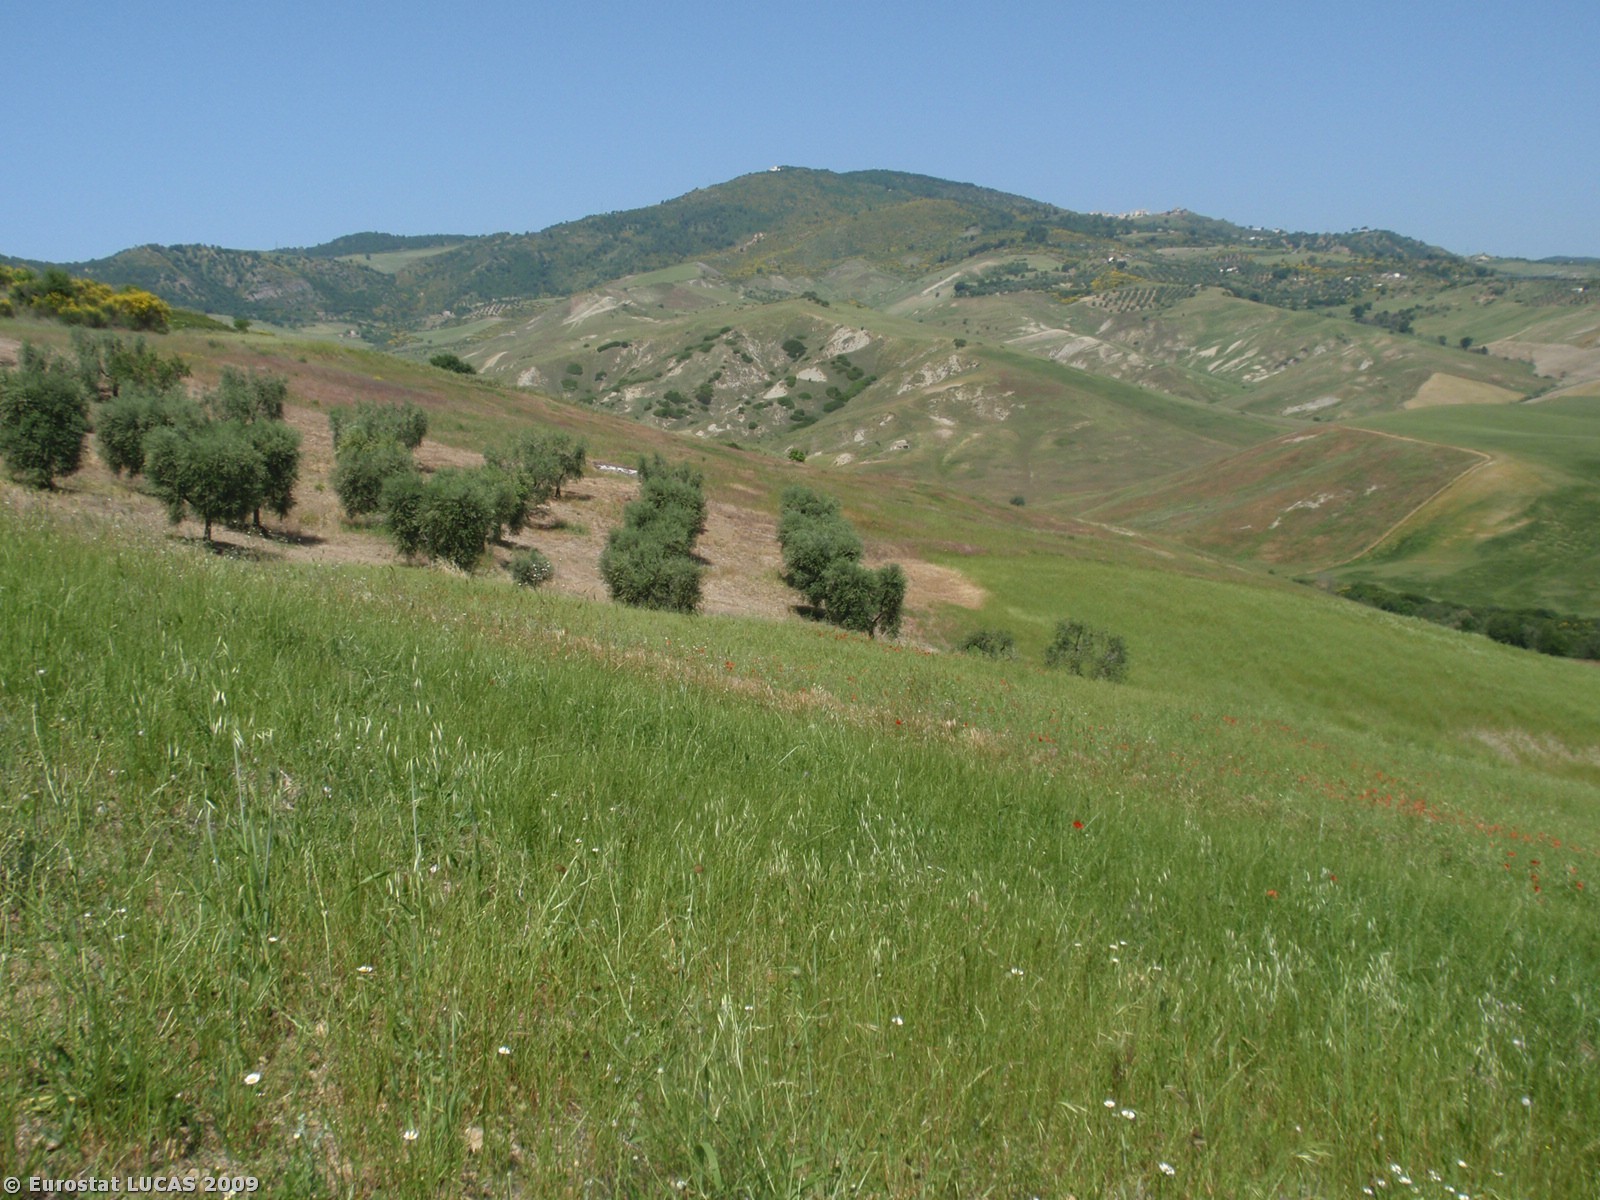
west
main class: Cropland
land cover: Mixed cereals for fodder
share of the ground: > 75 %
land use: Agriculture (excluding fallow land and kitchen gardens)
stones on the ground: < 10 %
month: May
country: IT
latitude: 40.3747
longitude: 16.2767
